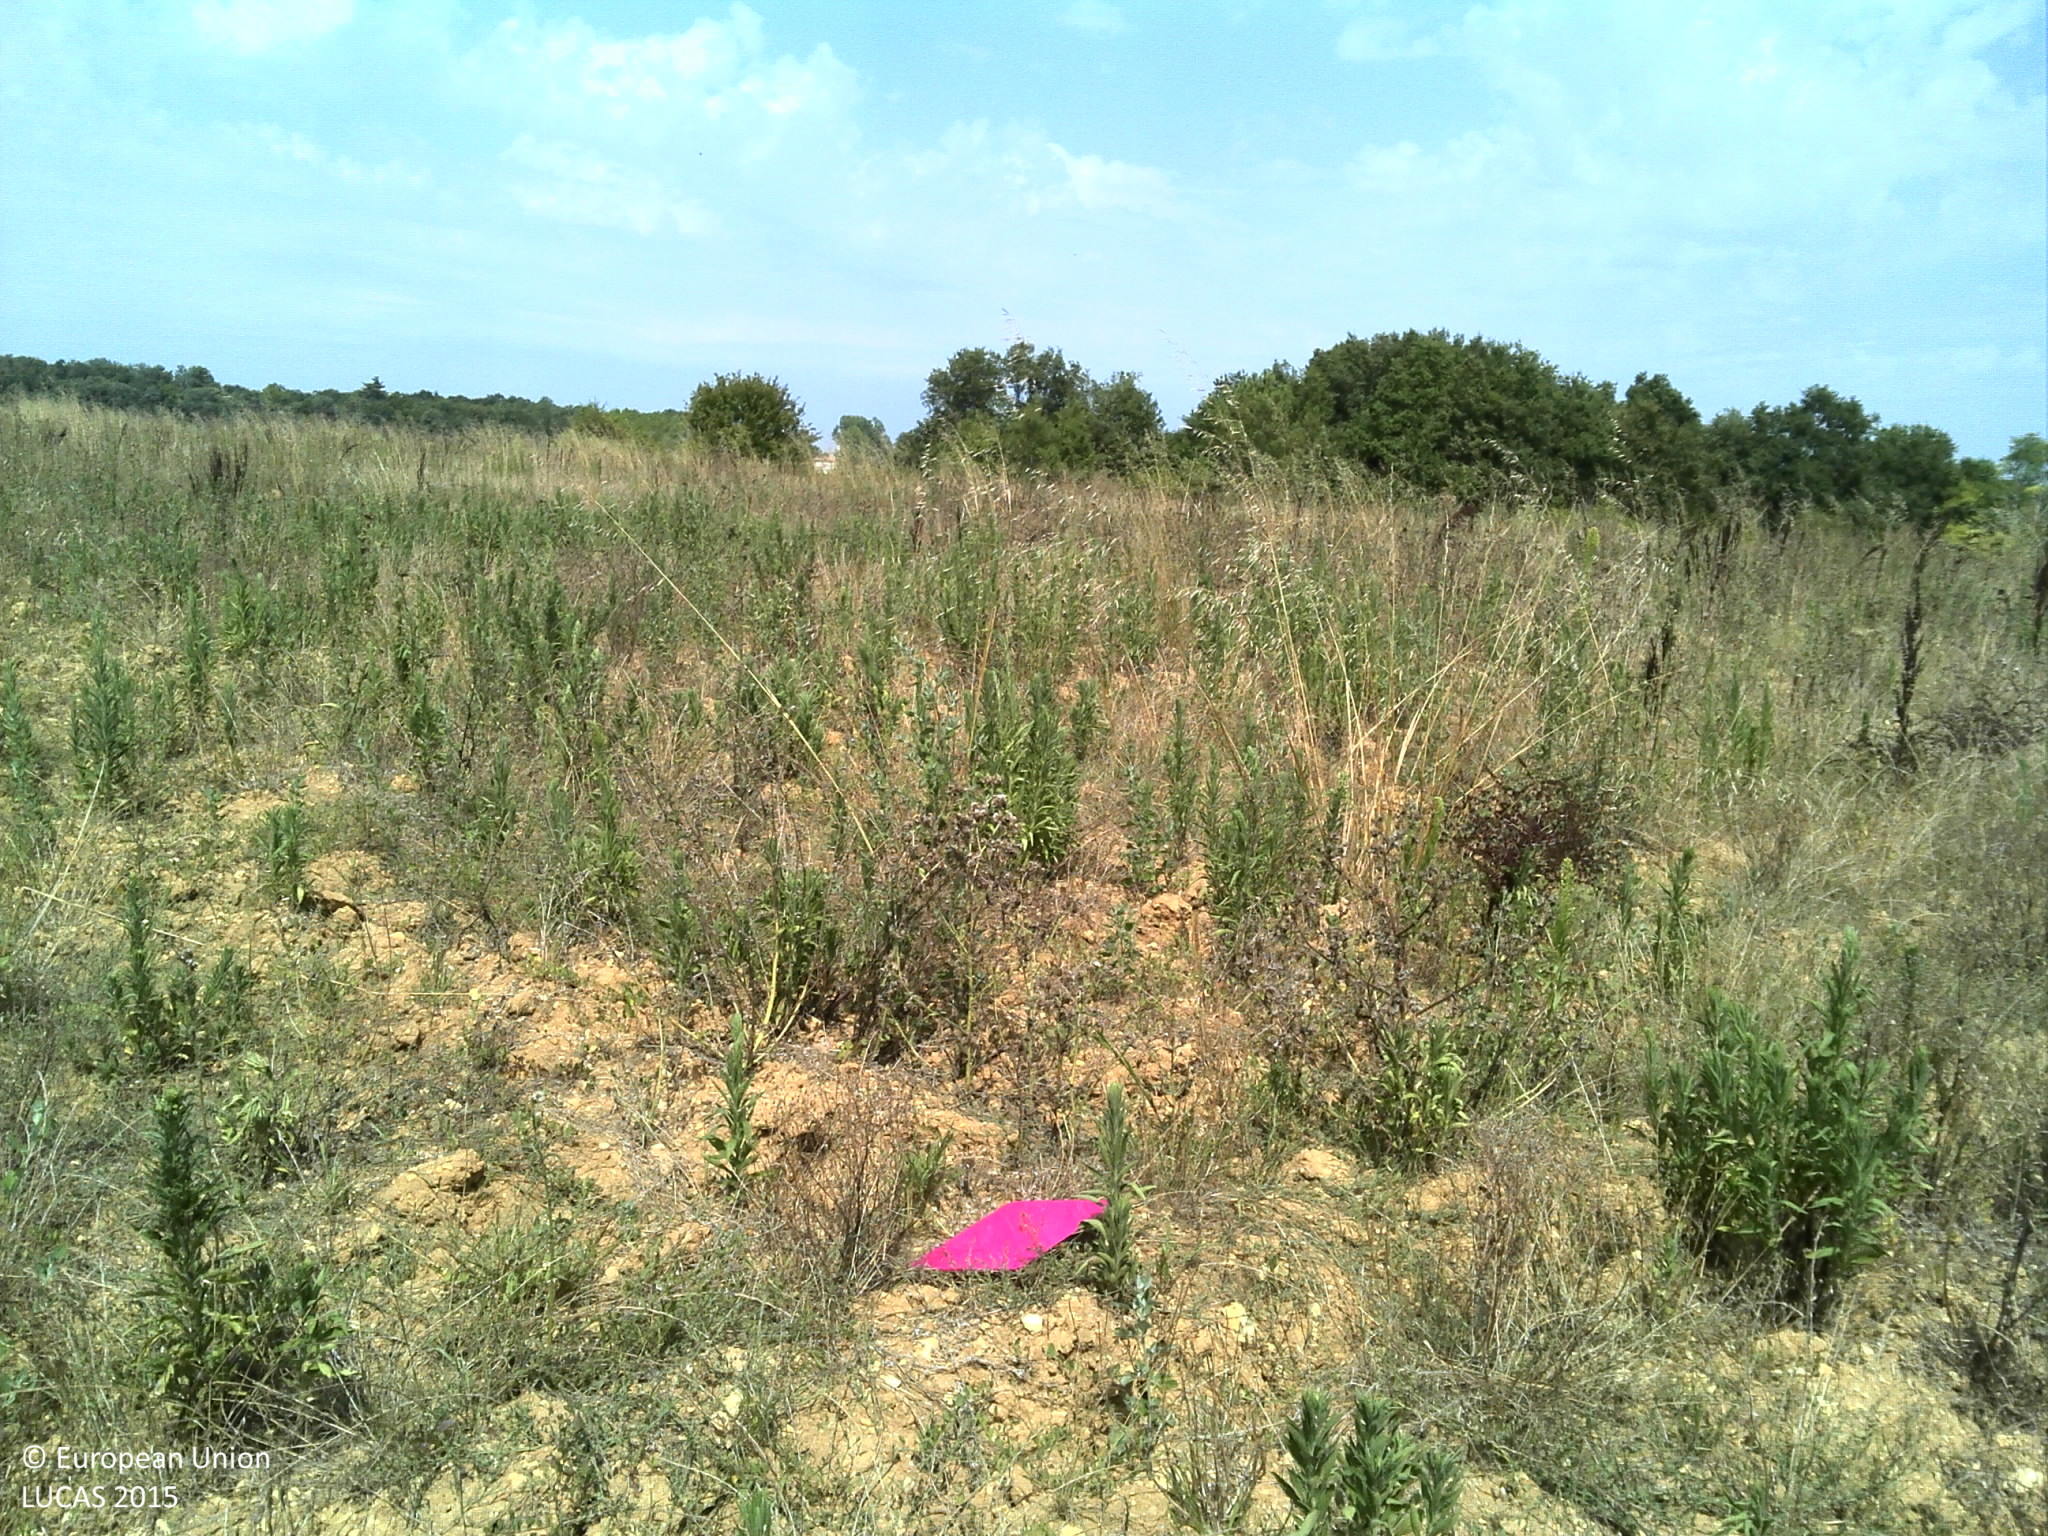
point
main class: Grassland
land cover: Spontaneously vegetated surfaces
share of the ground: 50 - 75 %
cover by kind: herbaceous plants 50 %, unconsolidated bare surface 50 %
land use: Semi-natural and natural areas not in use
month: August
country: FR
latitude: 45.2863
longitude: -0.8739
